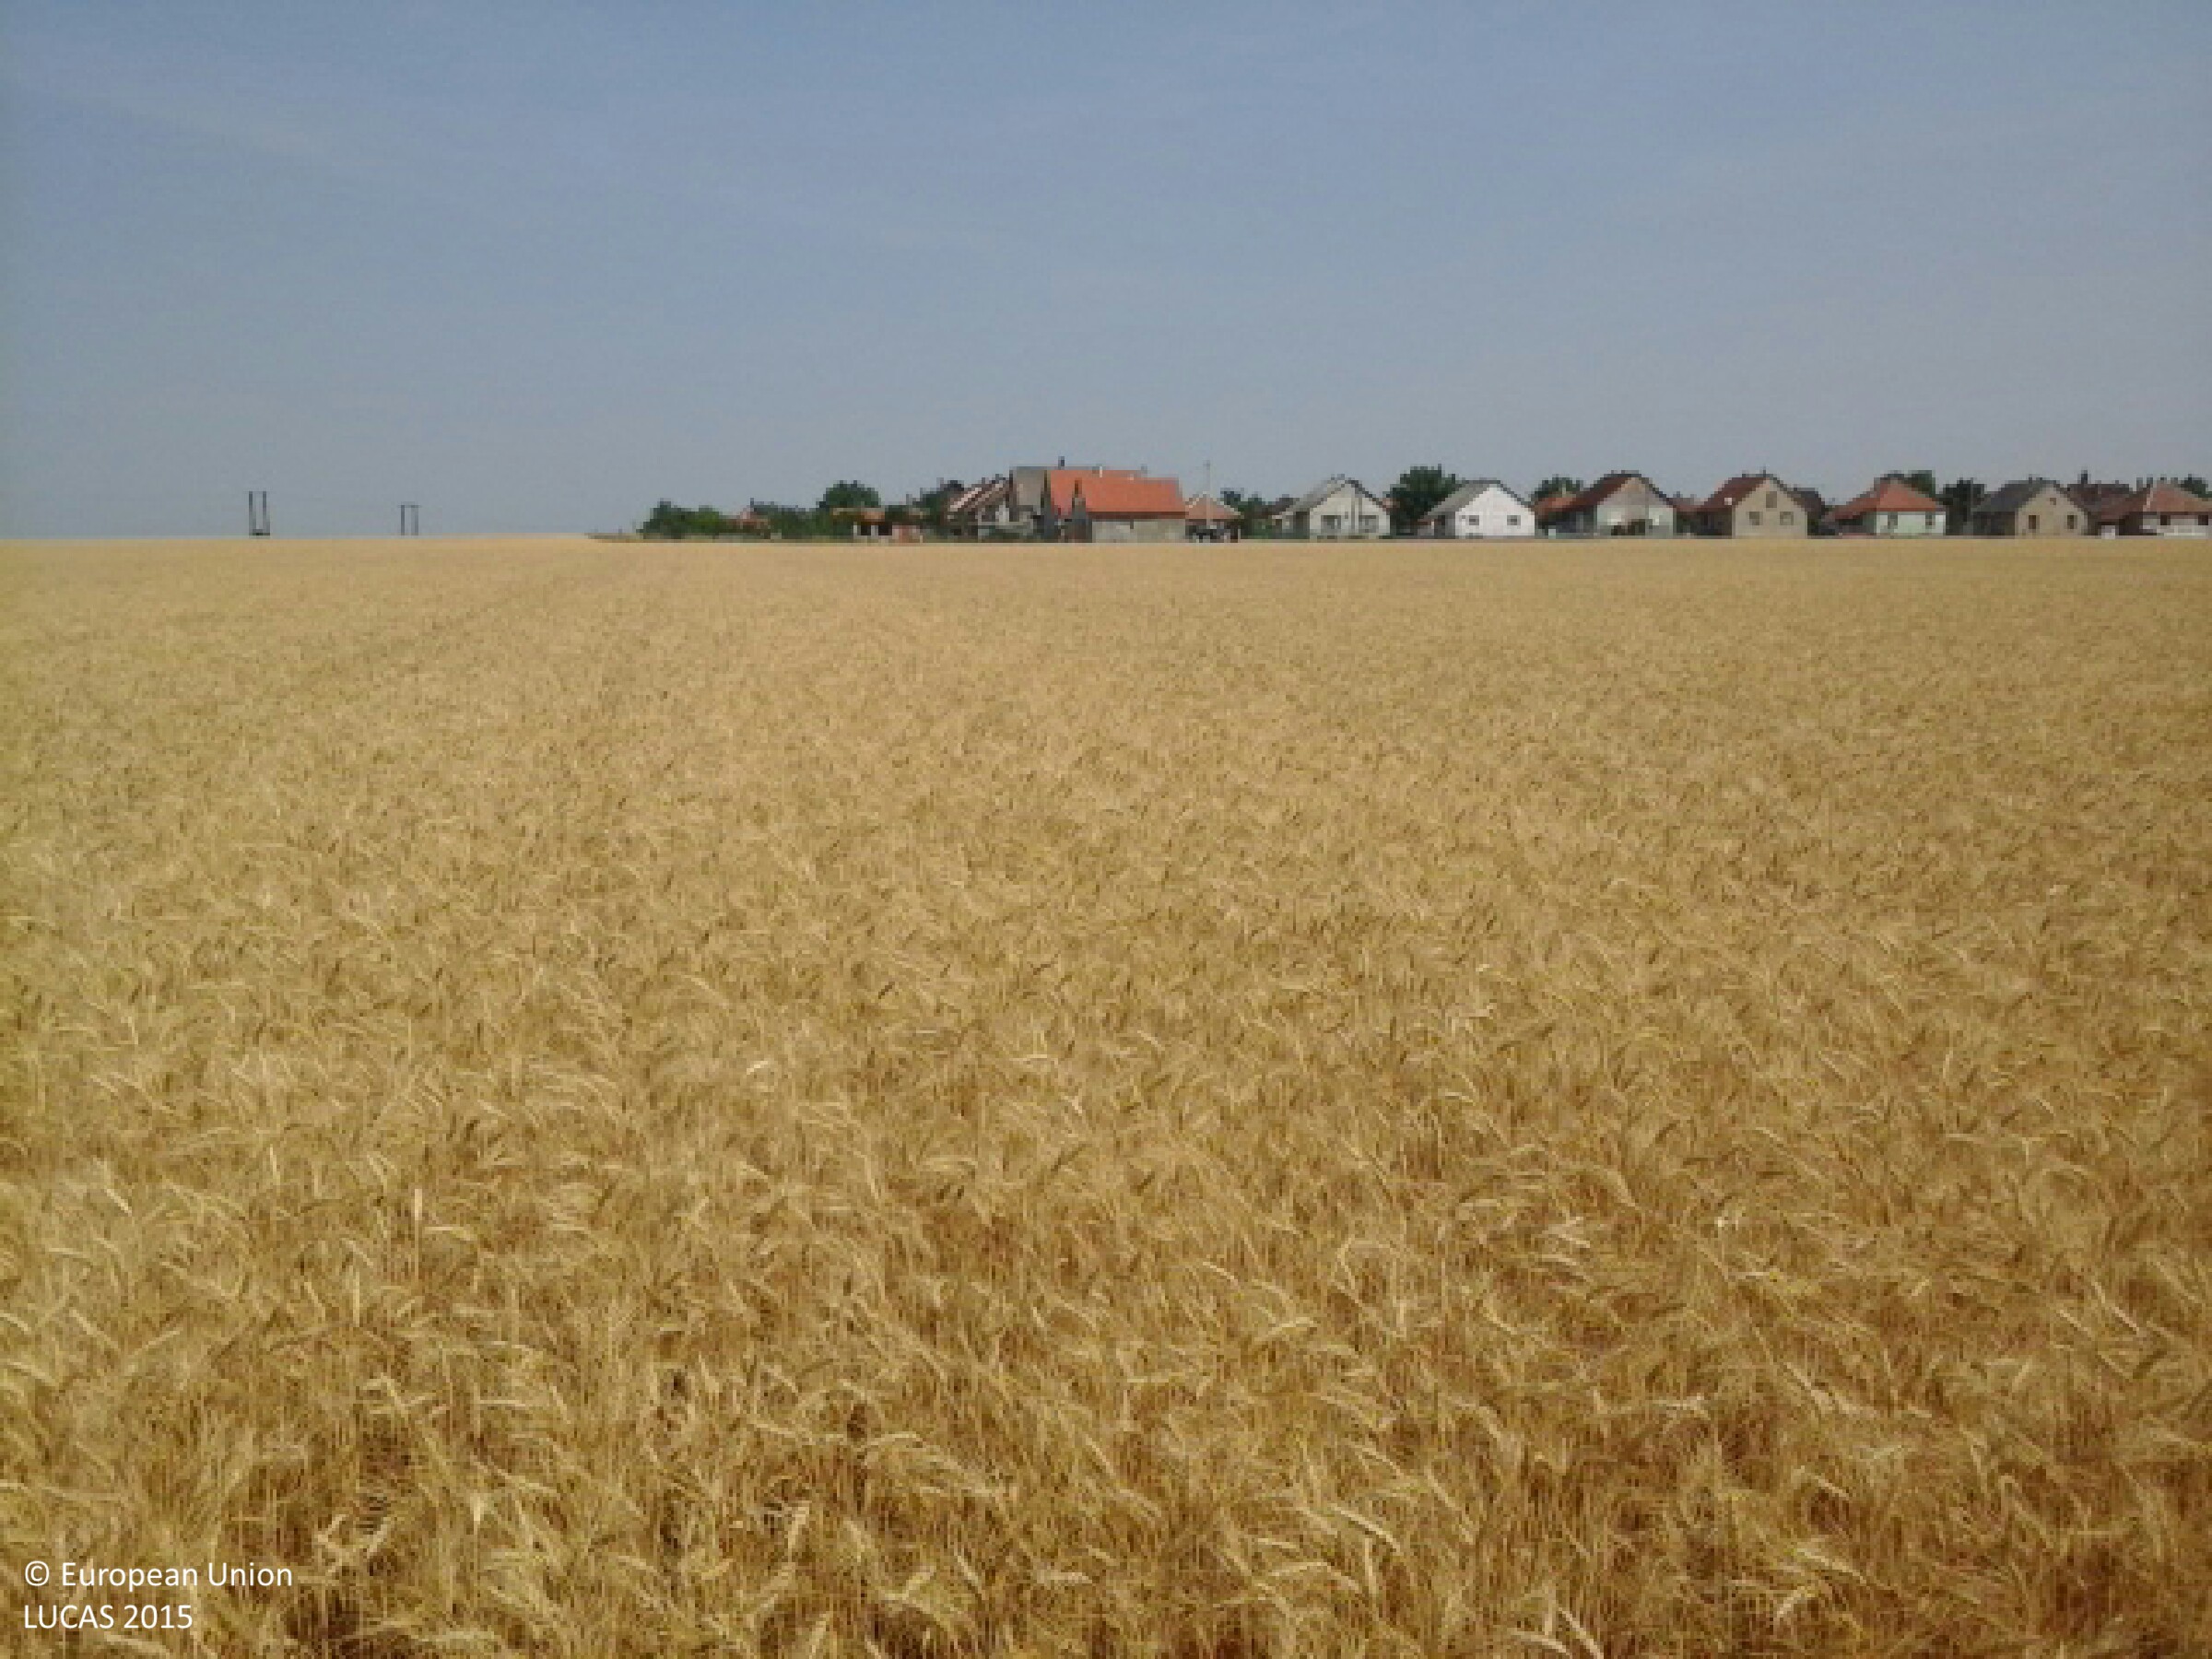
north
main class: Cropland
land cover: Triticale
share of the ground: > 75 %
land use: Agriculture (excluding fallow land and kitchen gardens)
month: July
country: HU
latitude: 48.0295
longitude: 21.0493
